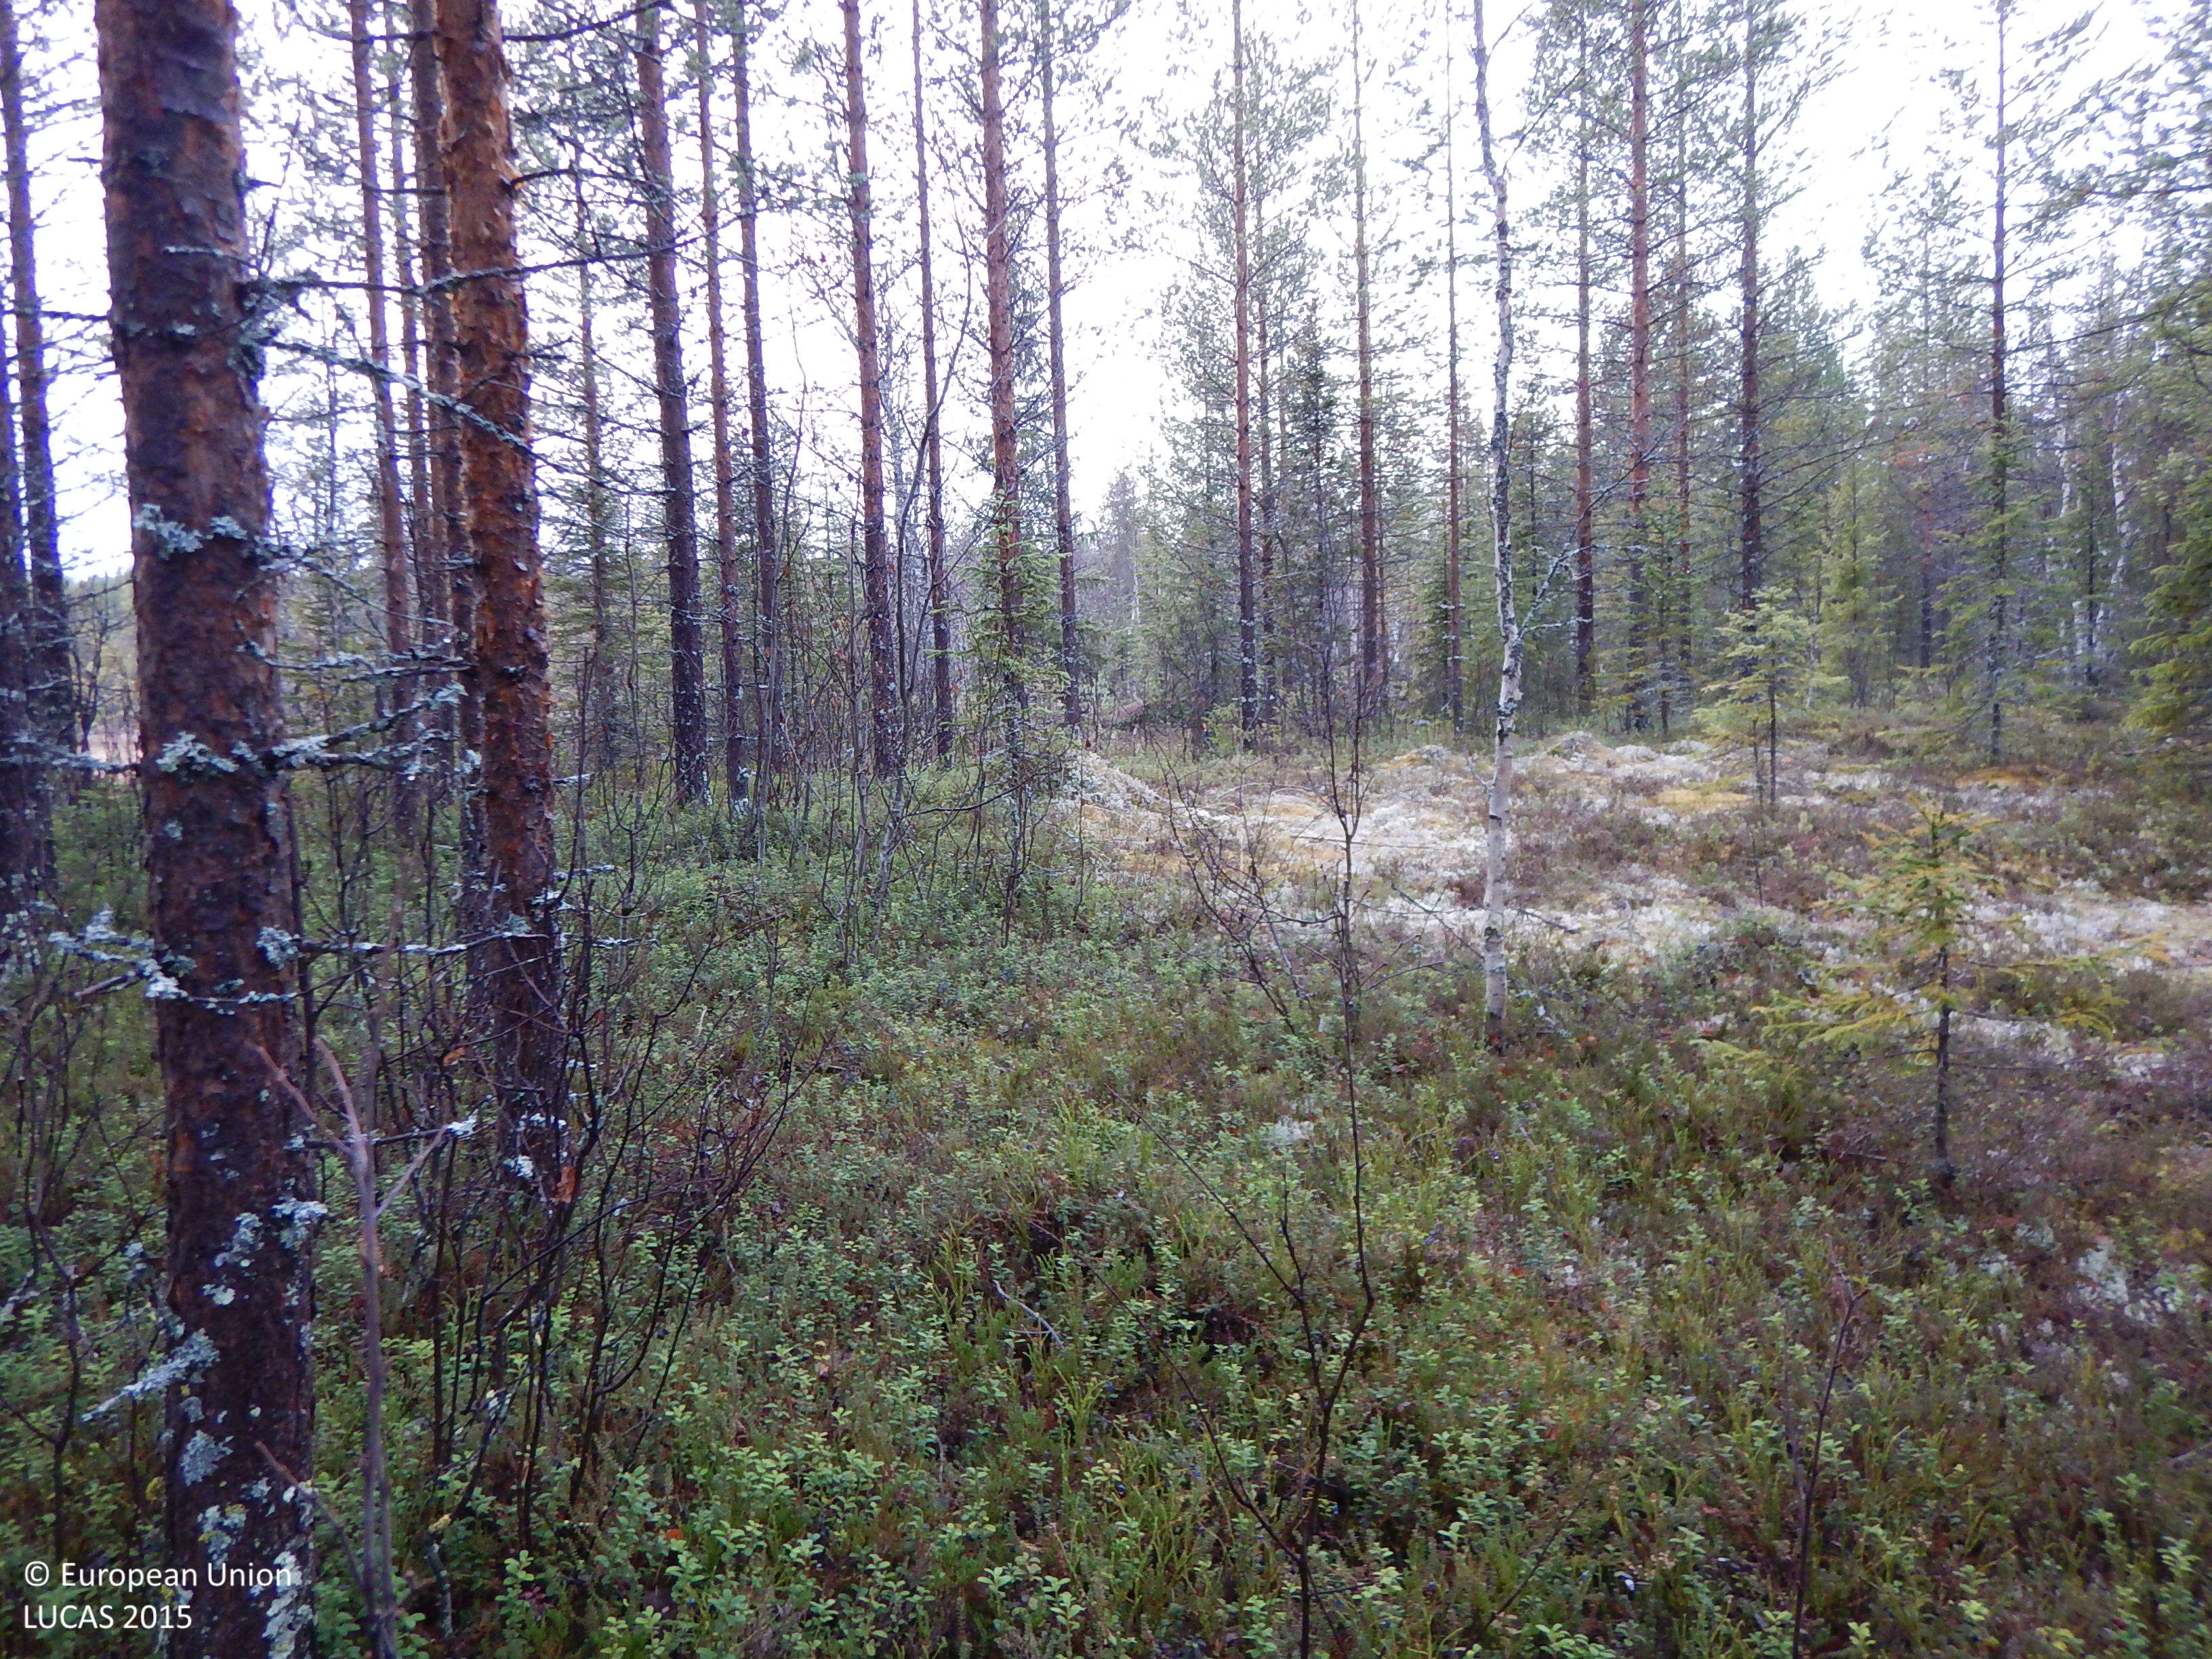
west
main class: Woodland
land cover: Pine dominated coniferous woodland
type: boreal forest
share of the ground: 50 - 75 %
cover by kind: coniferous forest trees 50 %, shrubs 25 %, lichens and mosses 15 %, broadleaved forest trees 5 %, herbaceous plants 5 %
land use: Forestry
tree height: > 5 m
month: November
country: SE
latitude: 65.2250
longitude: 20.3845
